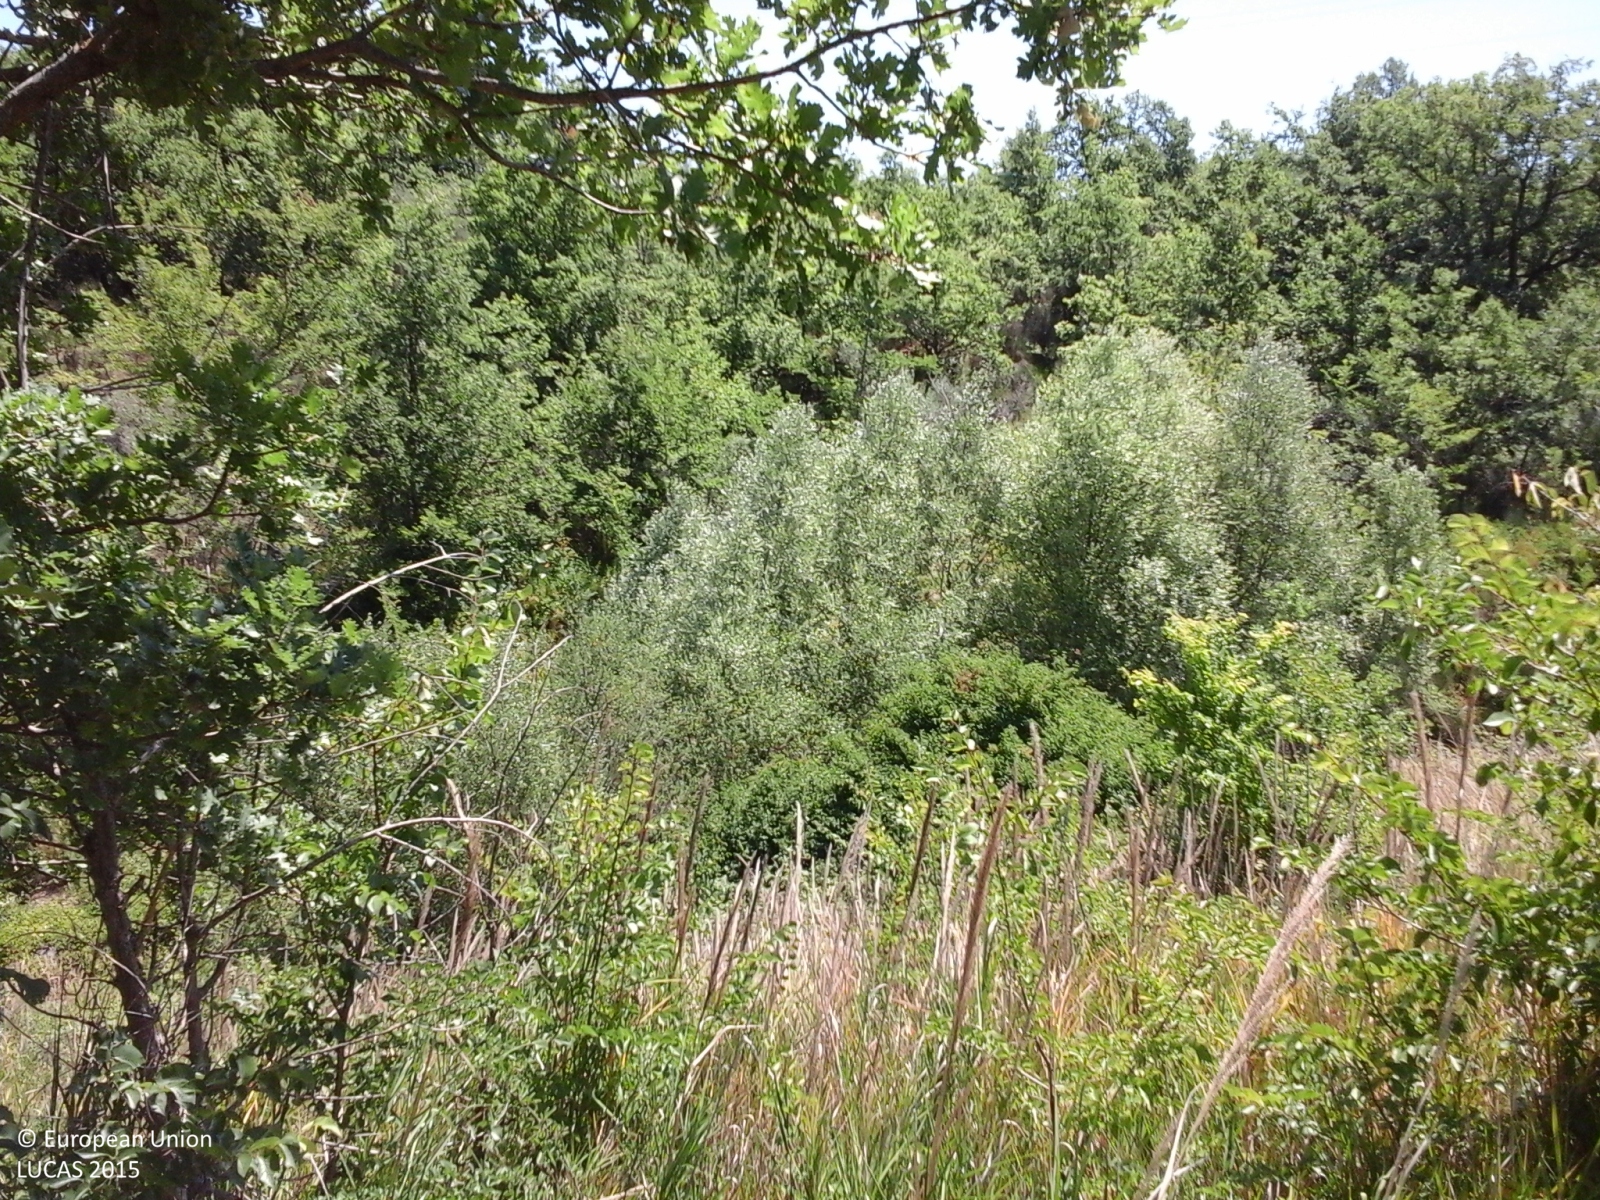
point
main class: Woodland
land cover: Broadleaved woodland
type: thermophilous deciduous forest
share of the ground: > 75 %
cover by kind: broadleaved forest trees 75 %, shrubs 15 %, herbaceous plants 10 %
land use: Semi-natural and natural areas not in use
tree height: > 5 m
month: July
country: IT
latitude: 41.7111
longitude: 14.7315
